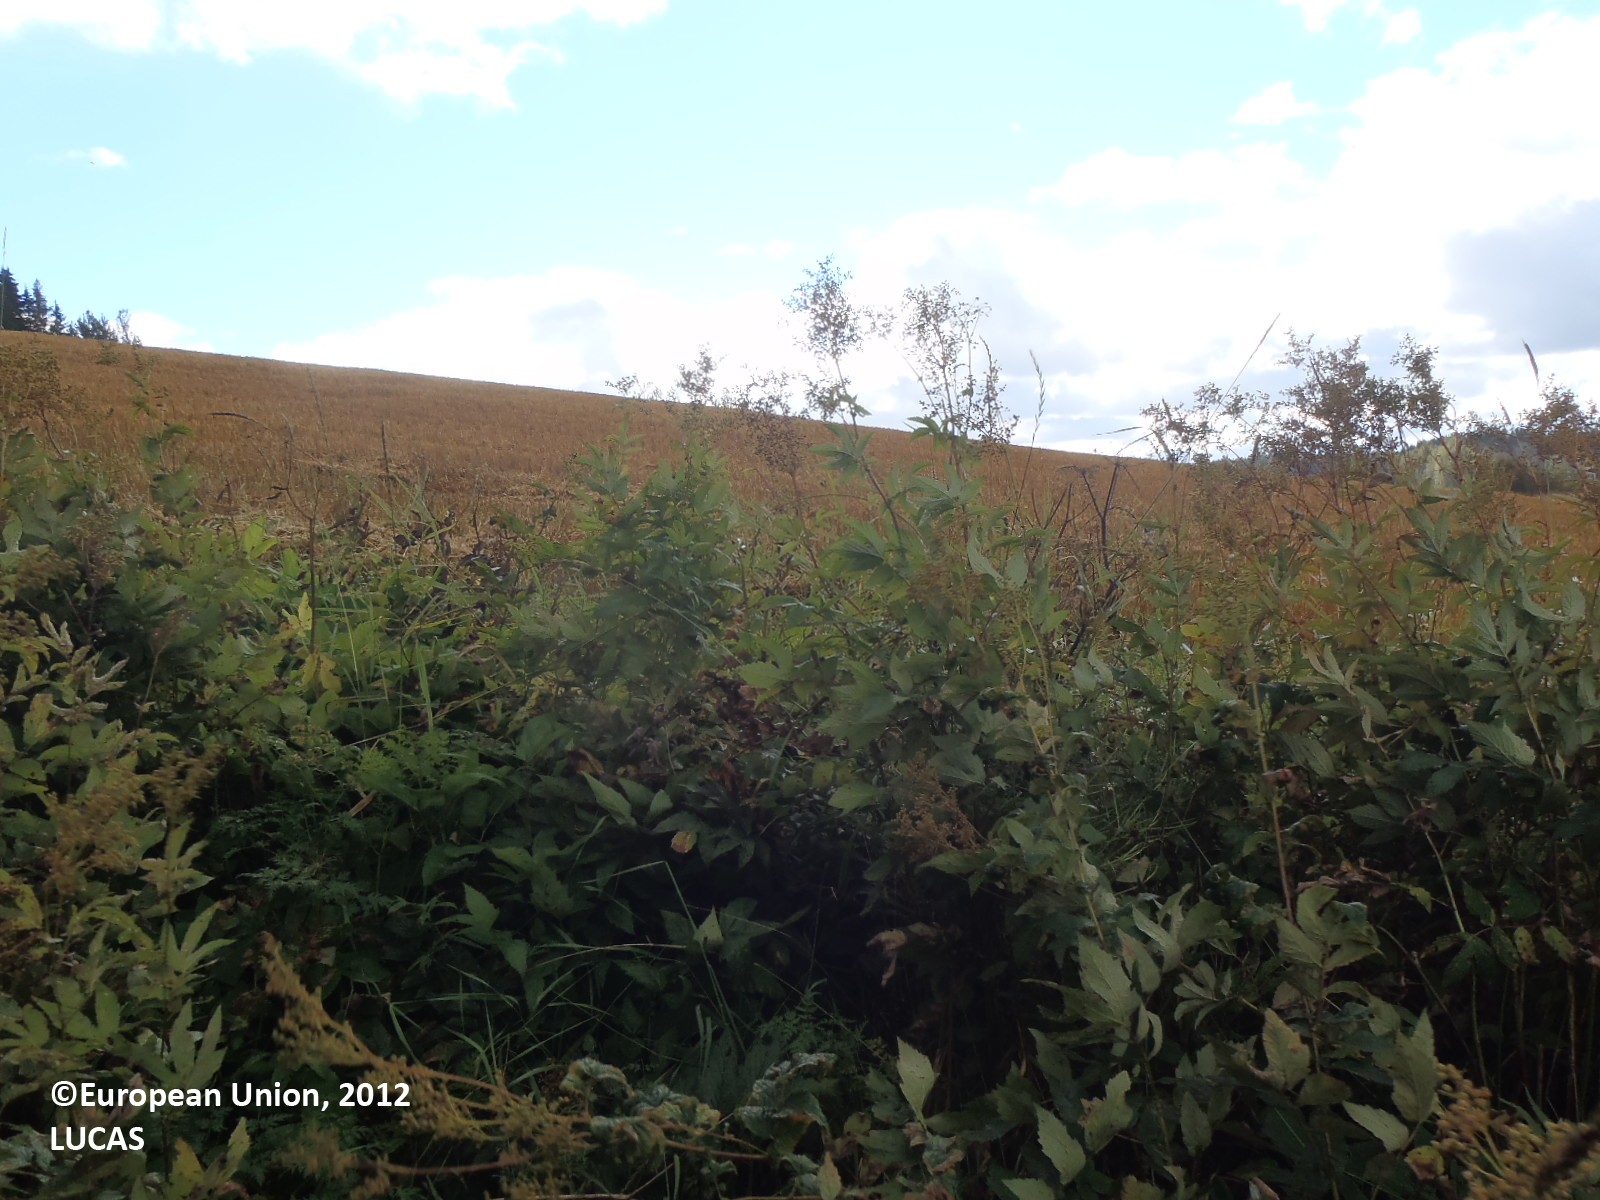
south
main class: Woodland
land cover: Broadleaved woodland
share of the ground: 50 - 75 %
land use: Forestry
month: September
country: FI
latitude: 61.6450
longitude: 22.7690
